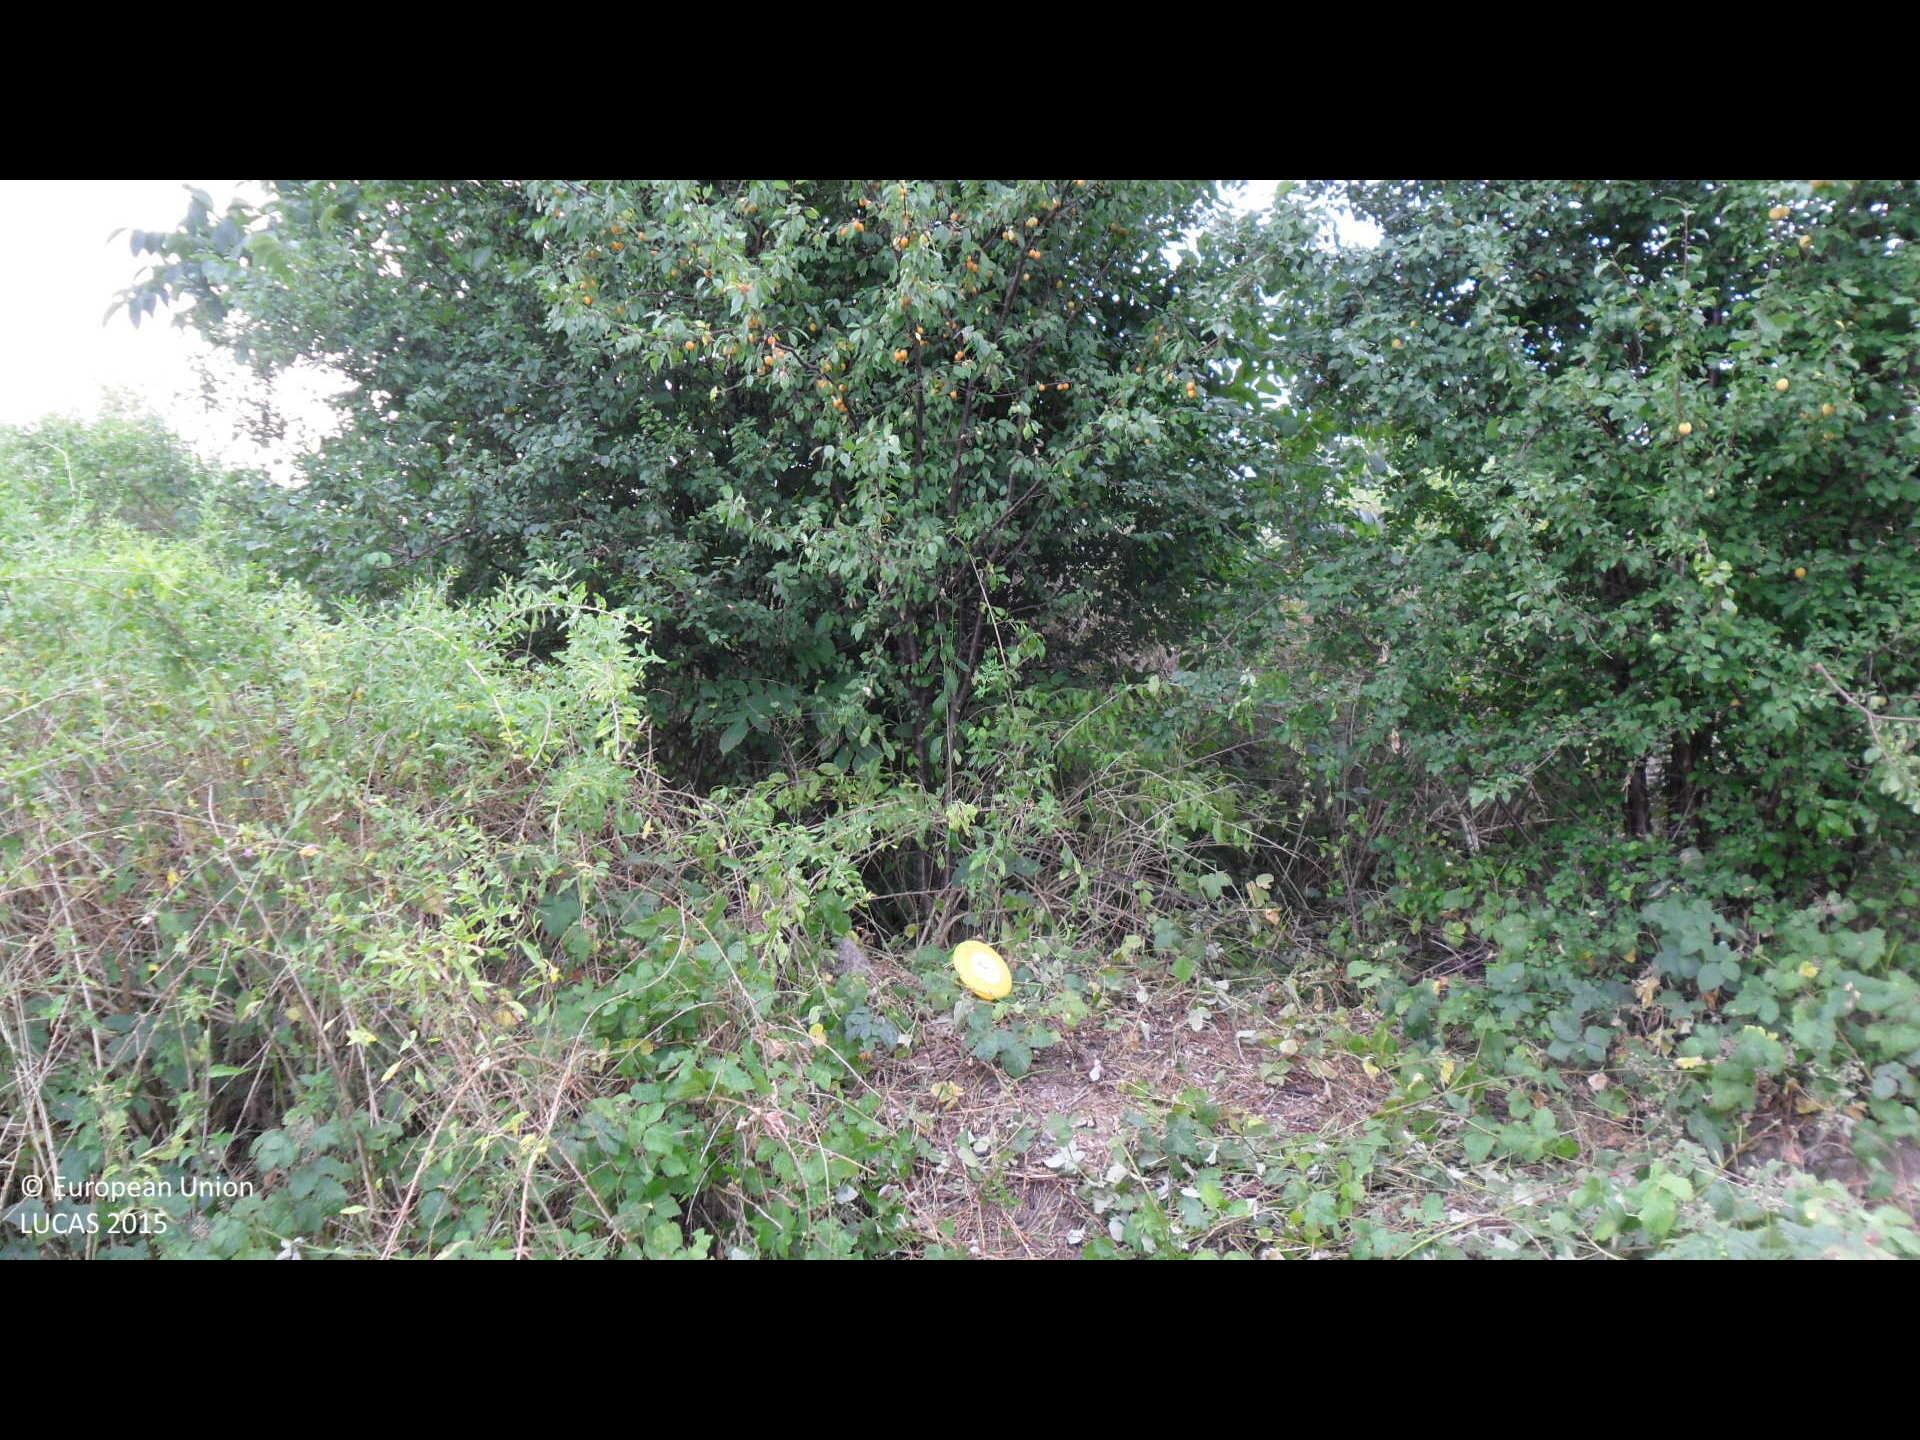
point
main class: Shrubland
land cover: Shrubland with sparse tree cover
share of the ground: > 75 %
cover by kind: shrubs 95 %, broadleaved forest trees 5 %
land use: Semi-natural and natural areas not in use
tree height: < 5 m
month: July
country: BG
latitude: 43.3537
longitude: 26.2469
